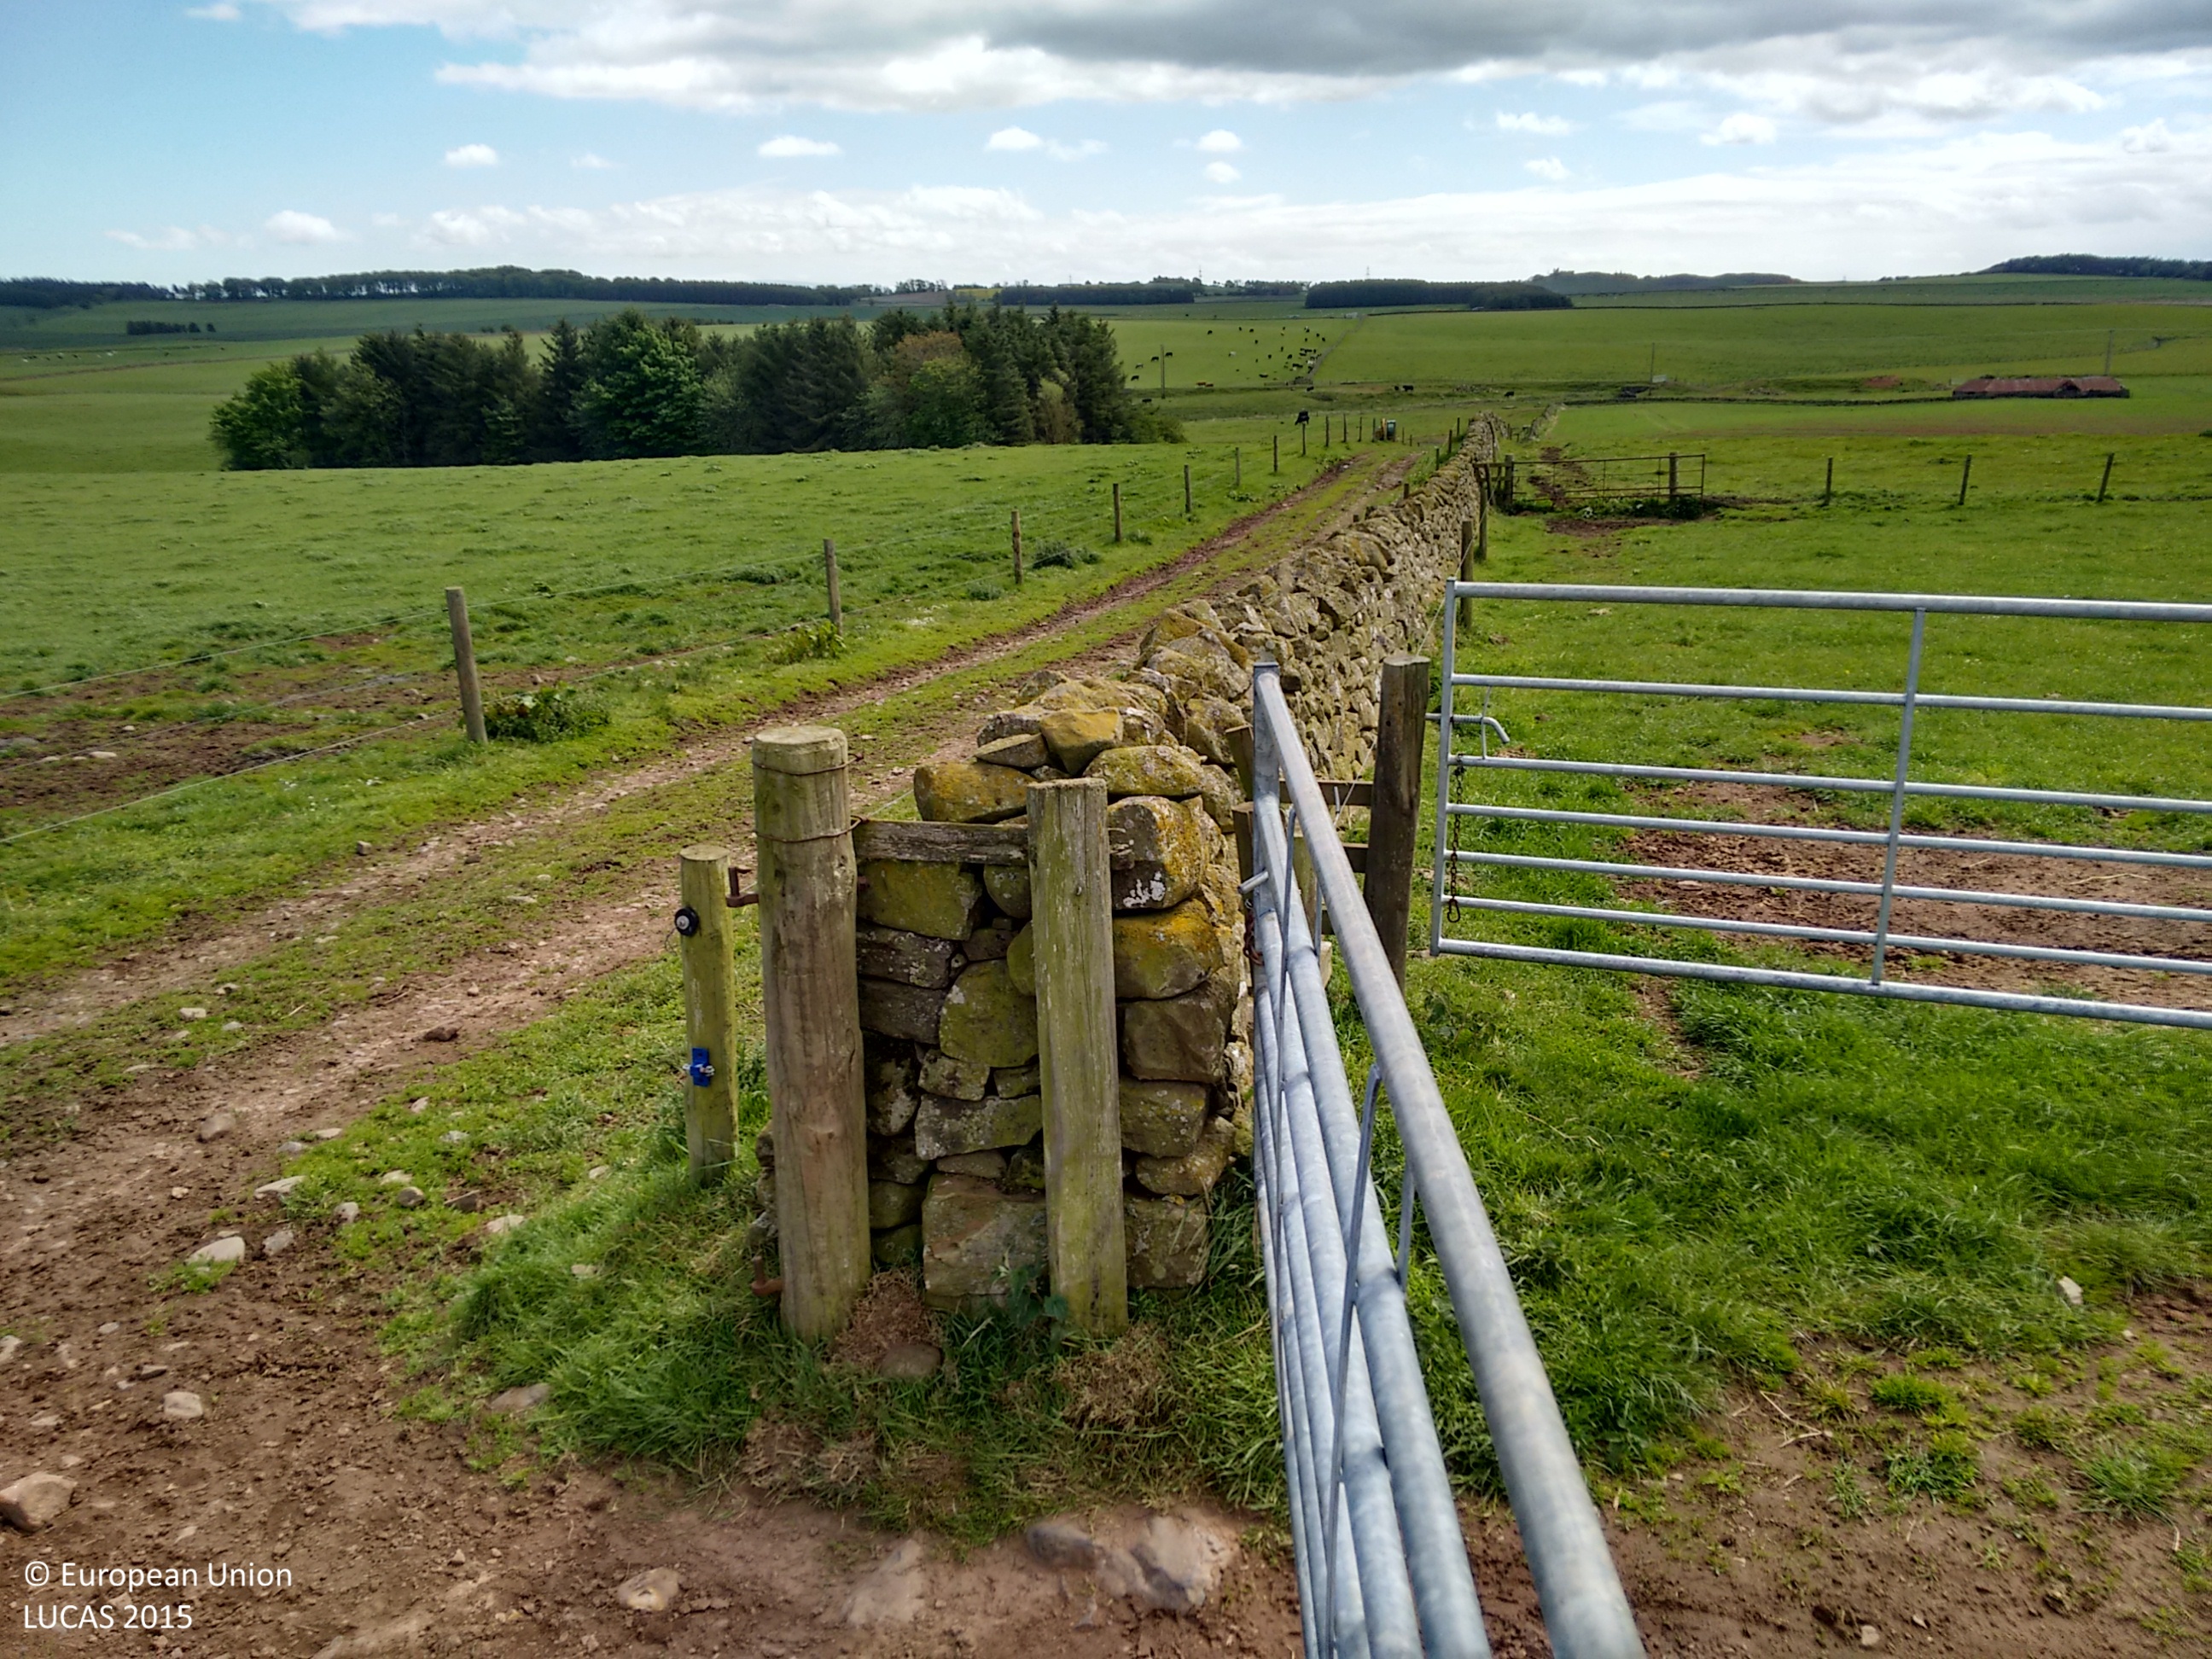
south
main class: Grassland
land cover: Grassland without tree/shrub cover
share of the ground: > 75 %
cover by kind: herbaceous plants 100 %
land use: Agriculture (excluding fallow land and kitchen gardens)
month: June
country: GB
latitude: 55.7023
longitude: -2.4877
